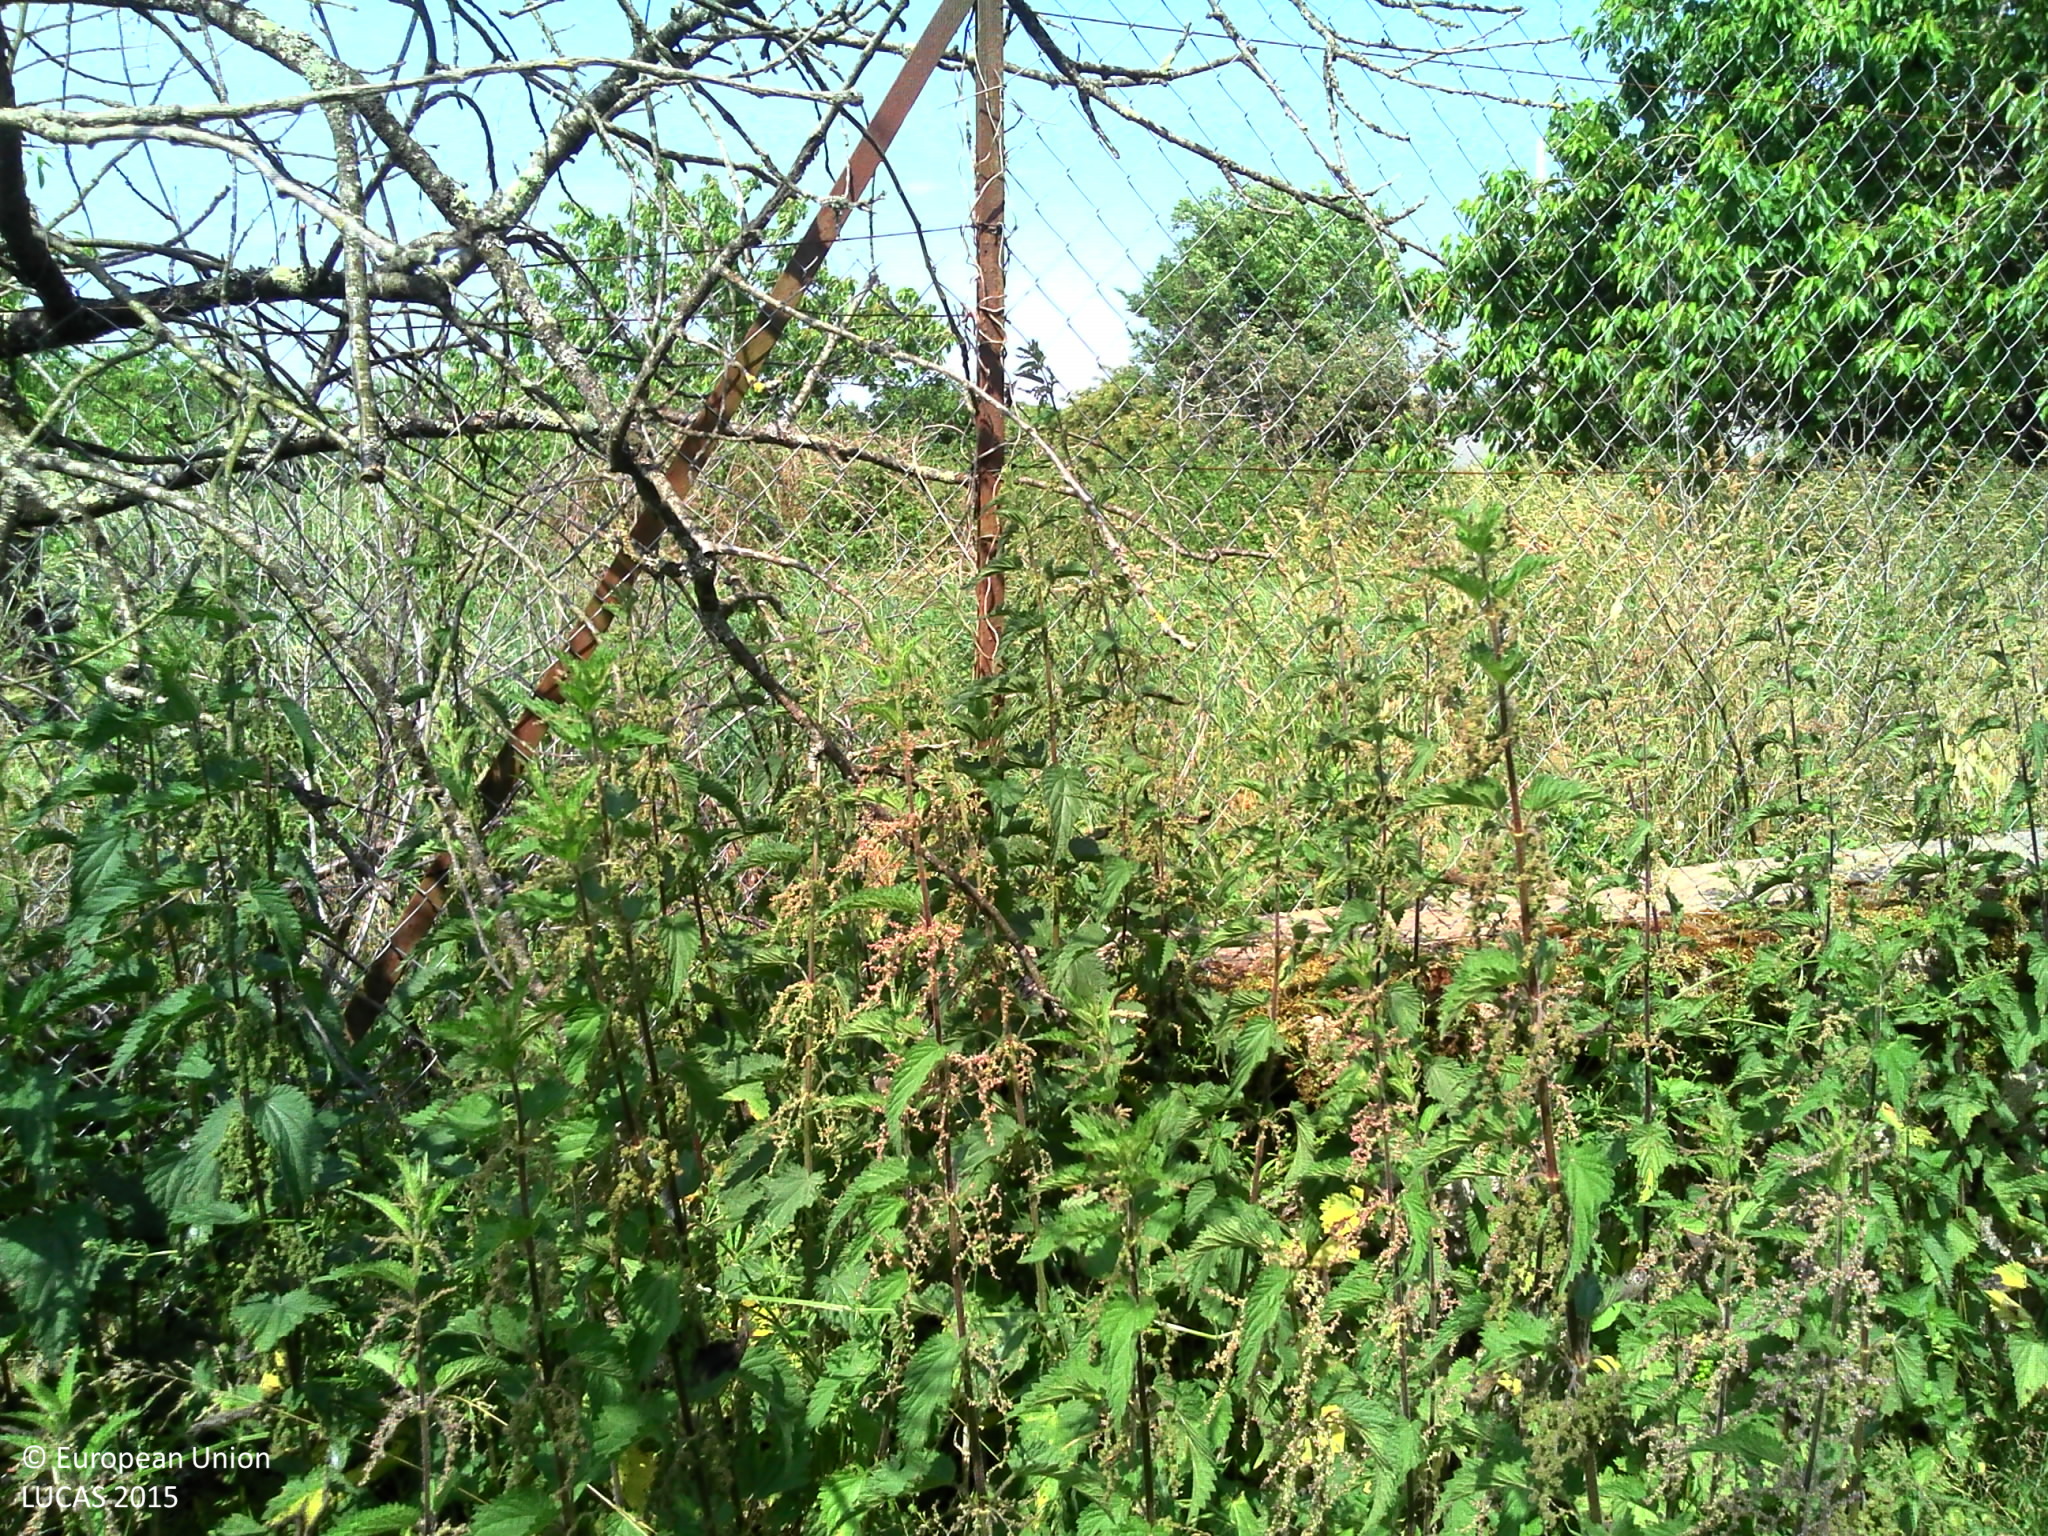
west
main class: Grassland
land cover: Grassland with sparse tree/shrub cover
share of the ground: > 75 %
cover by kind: herbaceous plants 95 %, broadleaved forest trees 5 %
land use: Agriculture (excluding fallow land and kitchen gardens)
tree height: > 5 m
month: June
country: FR
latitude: 46.6649
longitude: 0.8488
